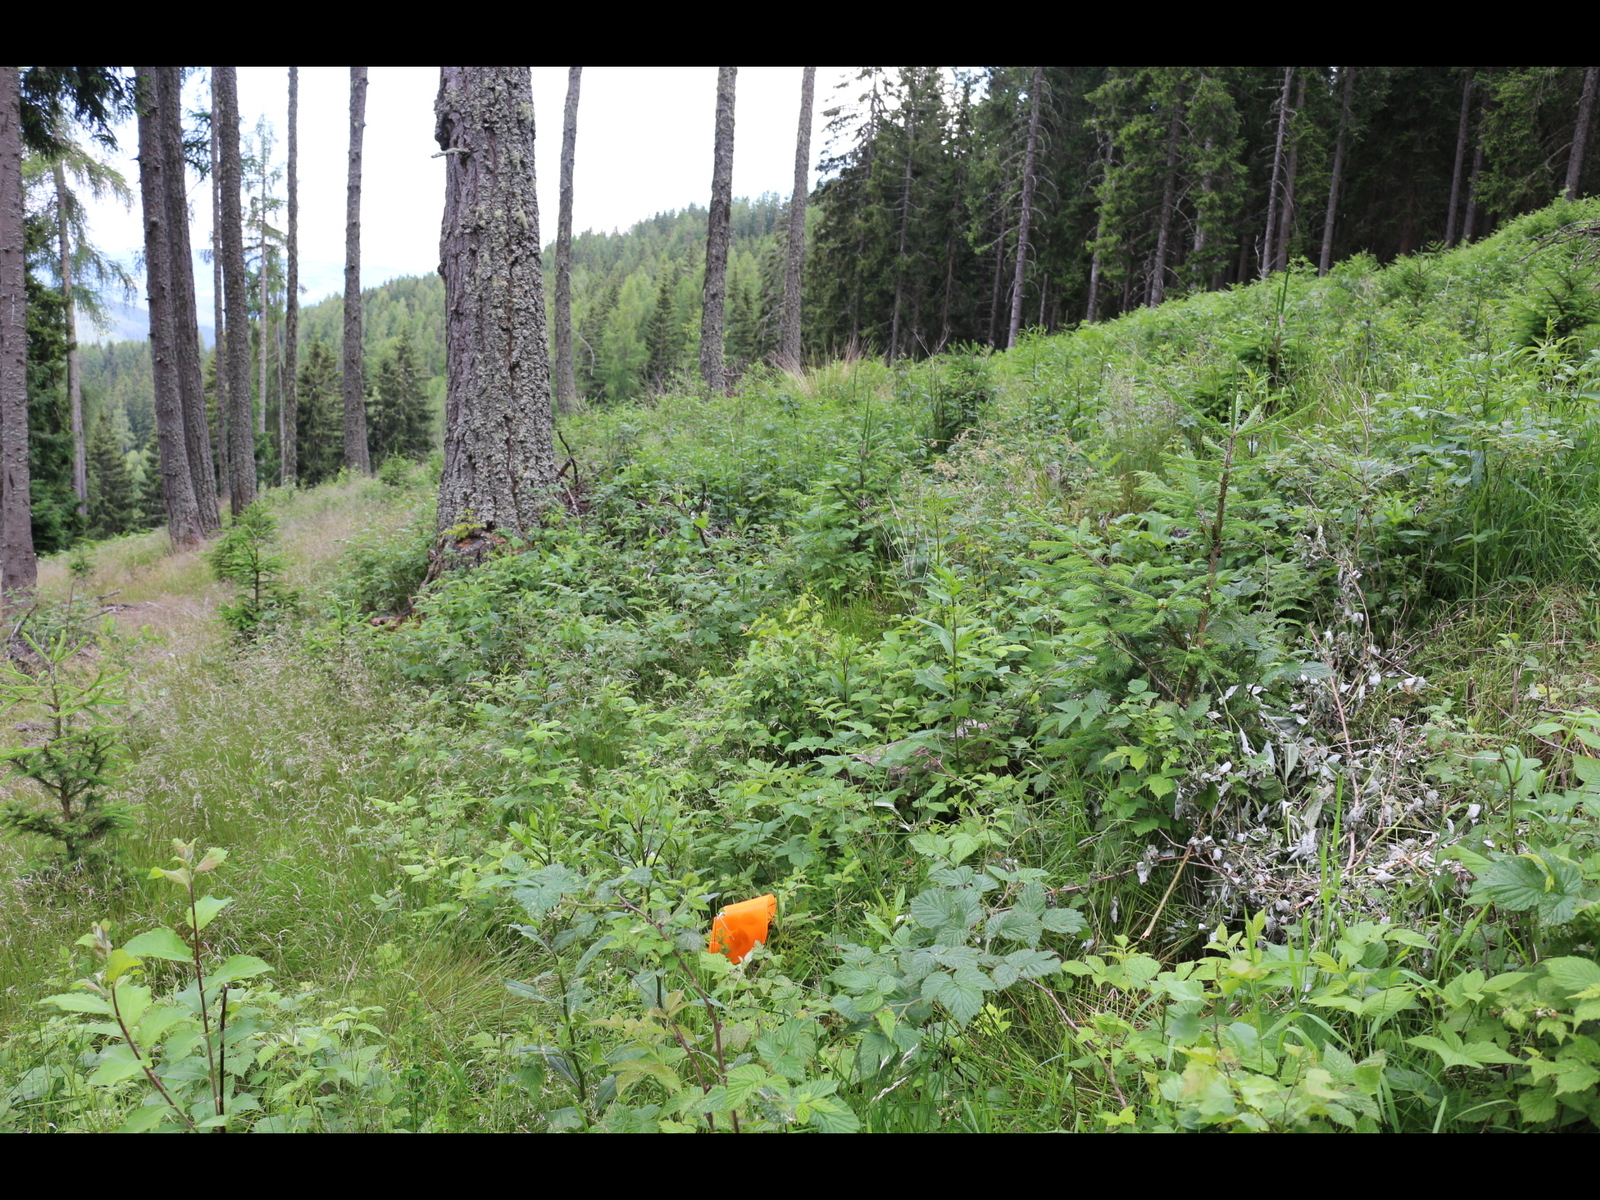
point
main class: Woodland
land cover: Other coniferous woodland
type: alpine coniferous forest
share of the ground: 25 - 50 %
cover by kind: herbaceous plants 60 %, coniferous forest trees 30 %, shrubs 10 %
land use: Forestry
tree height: > 5 m
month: June
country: AT
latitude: 46.9025
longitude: 14.1329
